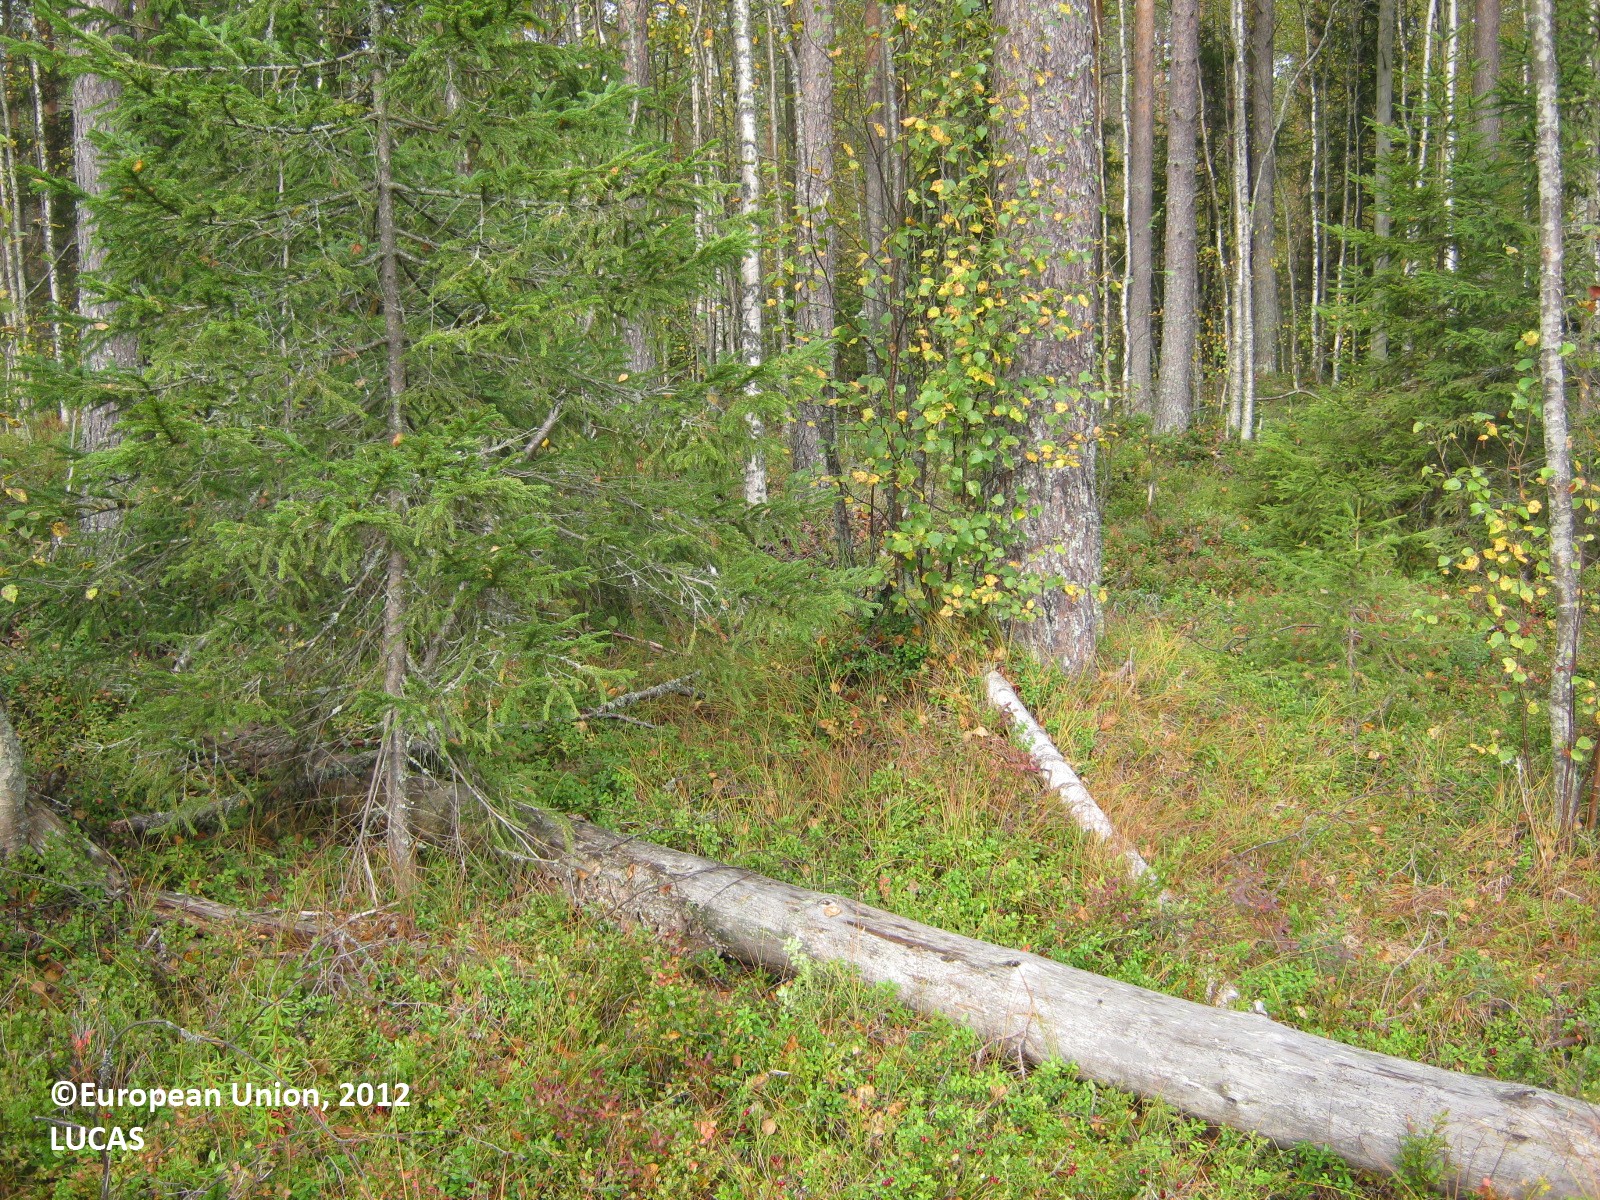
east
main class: Woodland
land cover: Other mixed woodland
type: boreal forest
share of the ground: > 75 %
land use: Forestry
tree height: > 5 m
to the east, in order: Other mixed woodland; Ditches and canals; Pine dominated coniferous woodland
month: September
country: FI
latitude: 60.8416
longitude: 27.5734
